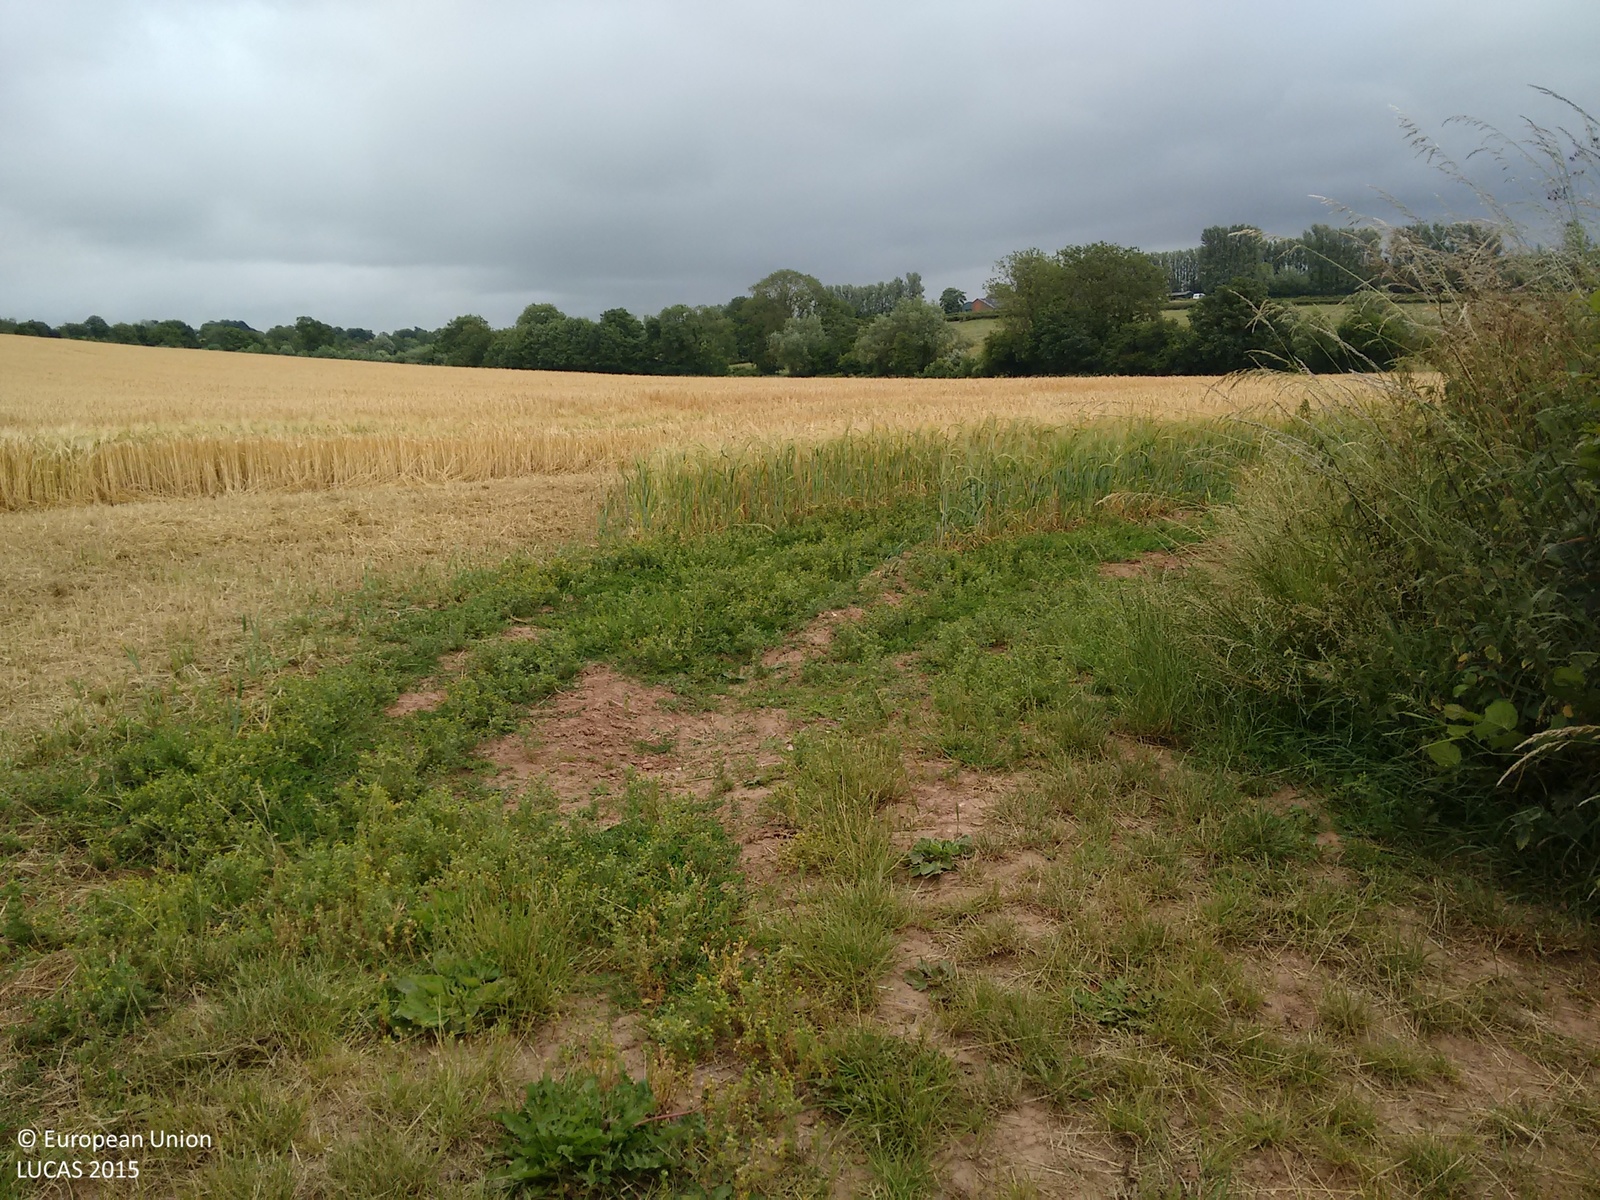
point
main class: Cropland
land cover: Barley
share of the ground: > 75 %
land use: Agriculture (excluding fallow land and kitchen gardens)
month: July
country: GB
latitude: 52.2373
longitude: -2.7073
